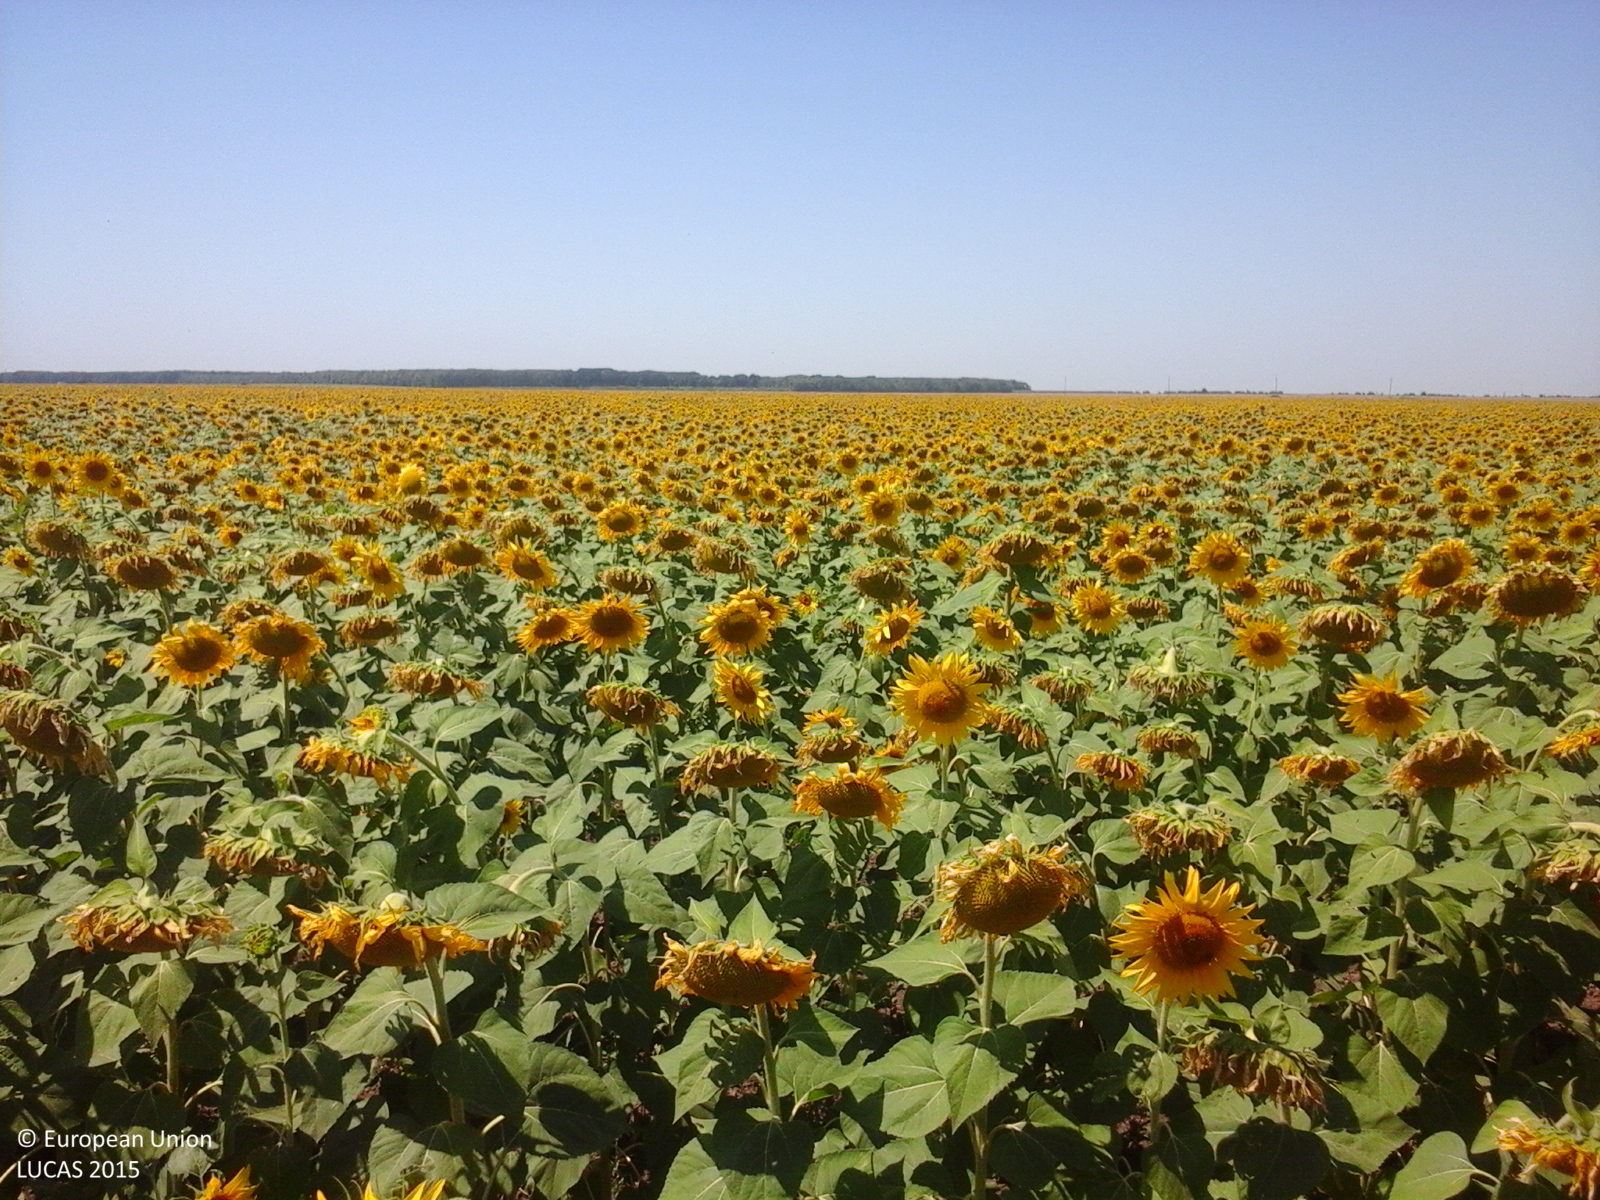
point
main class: Cropland
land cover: Sunflower
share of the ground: > 75 %
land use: Agriculture (excluding fallow land and kitchen gardens)
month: July
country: RO
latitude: 44.2546
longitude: 26.5850
